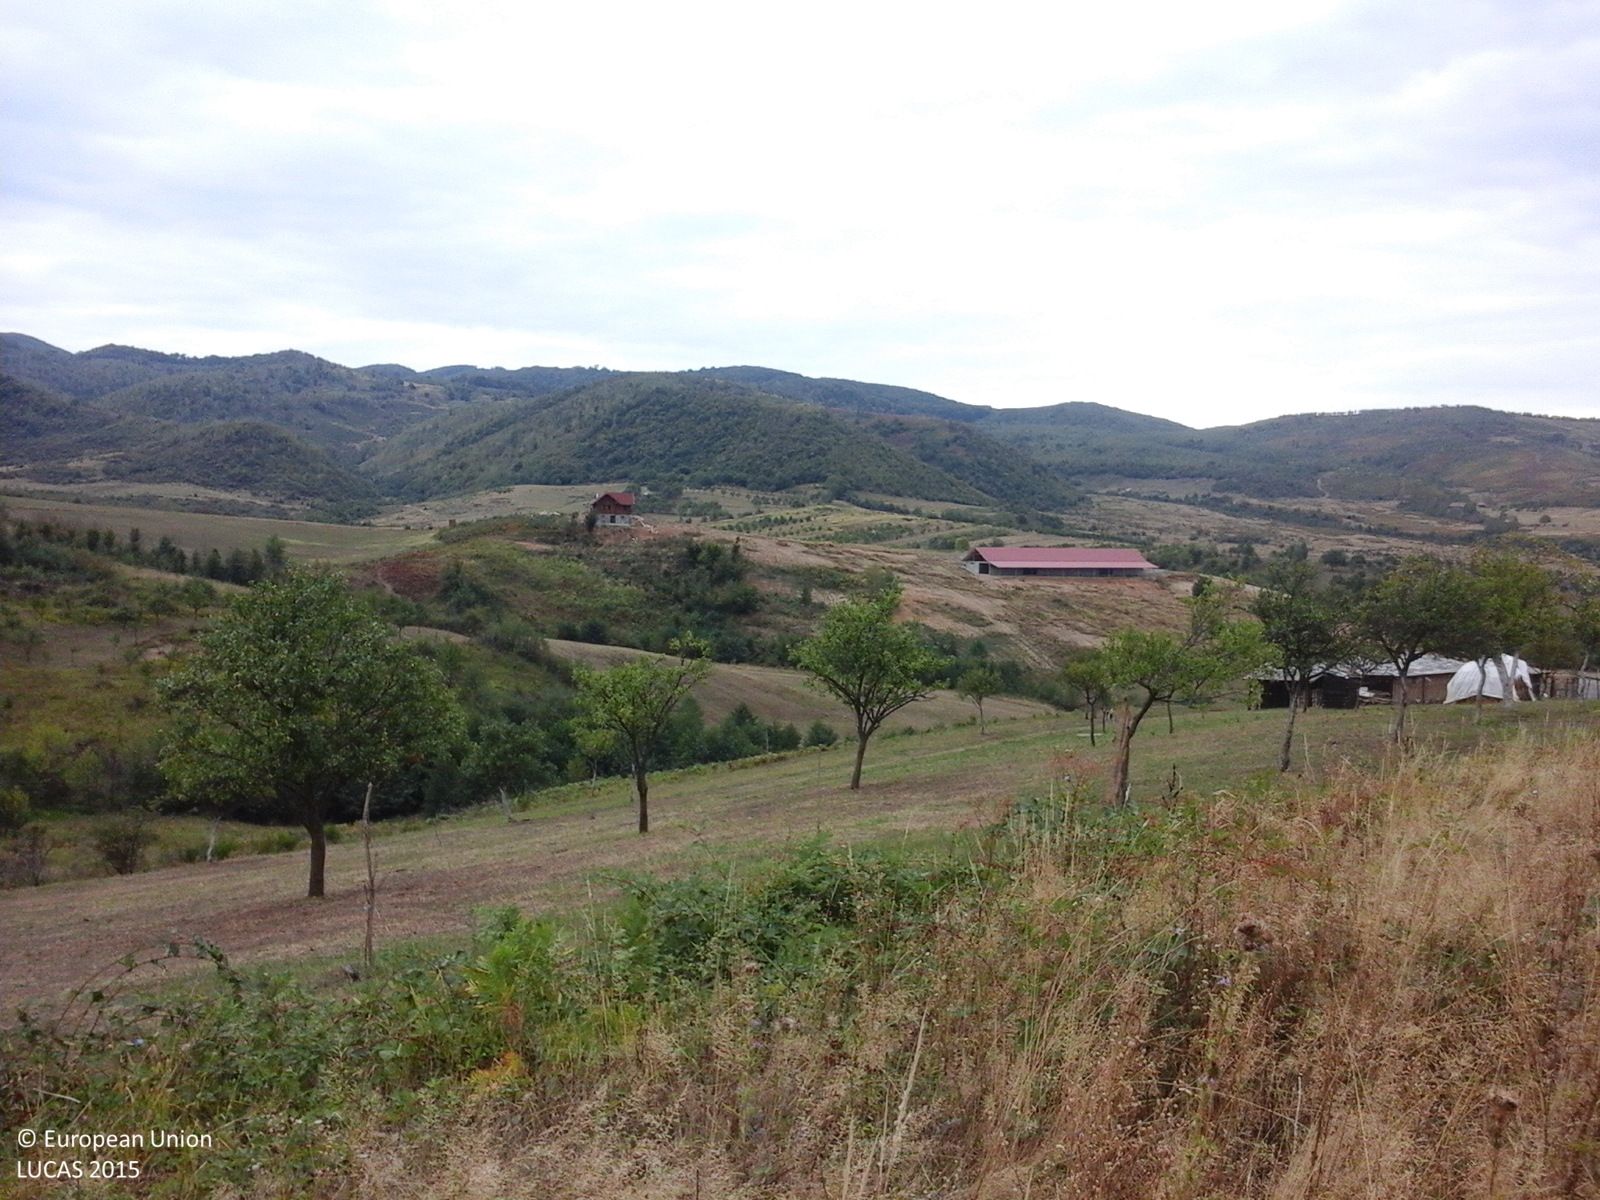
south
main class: Grassland
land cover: Spontaneously vegetated surfaces
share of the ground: > 75 %
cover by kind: herbaceous plants 100 %
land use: Fallow land
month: September
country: RO
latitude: 47.8216
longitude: 23.3903
